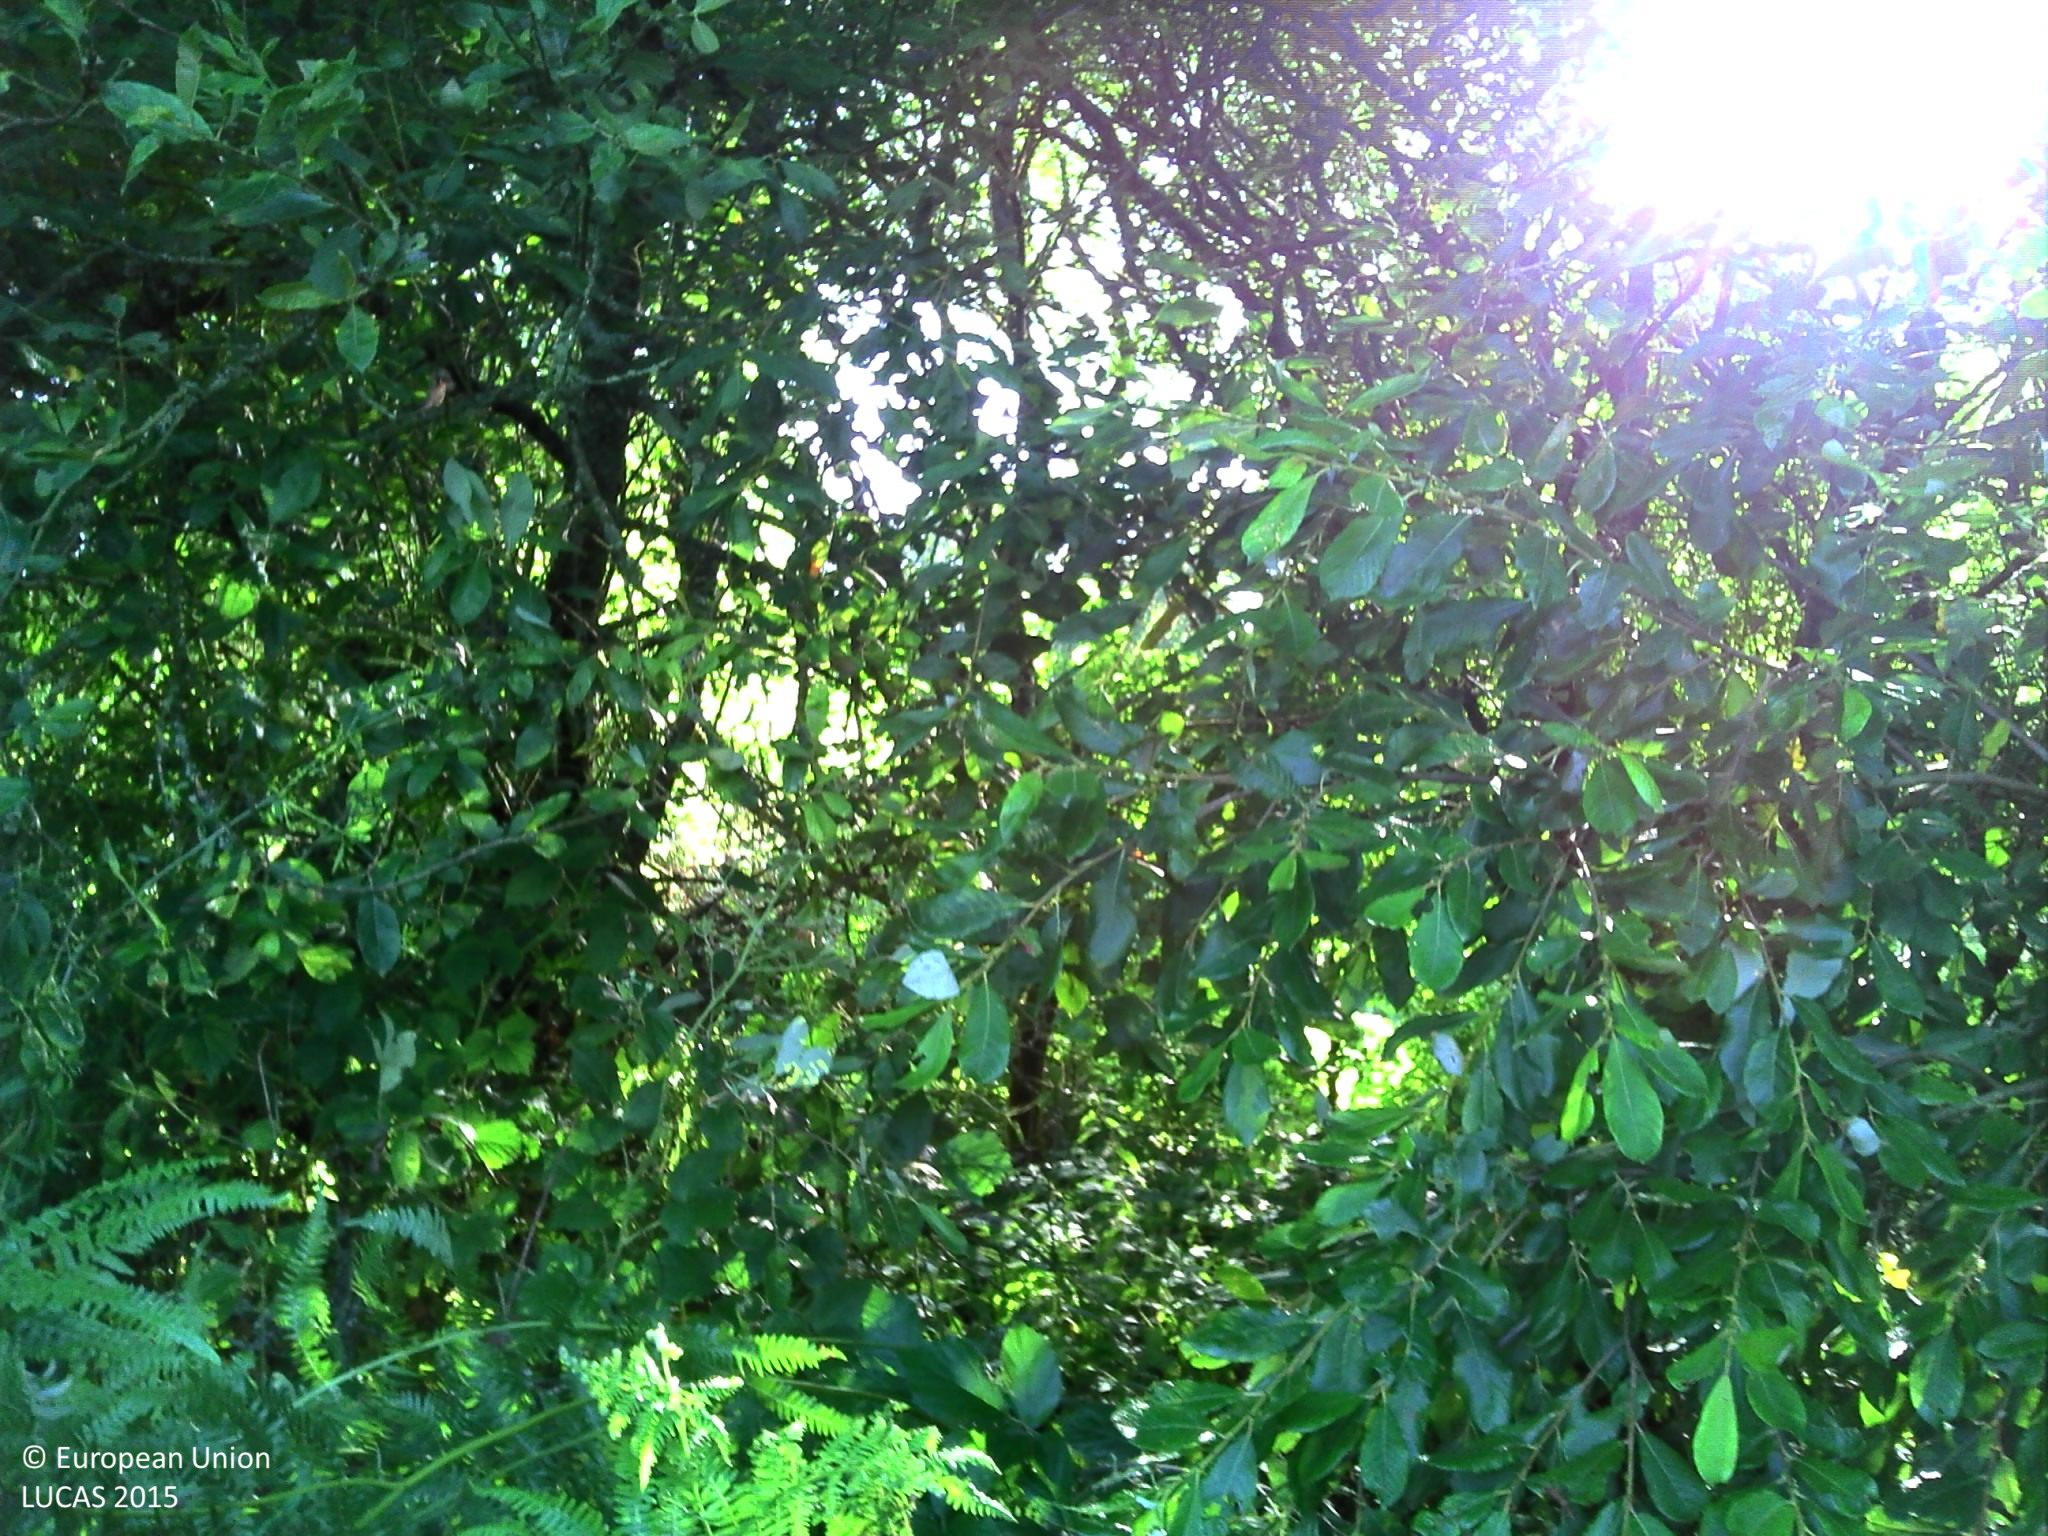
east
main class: Woodland
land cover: Broadleaved woodland
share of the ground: > 75 %
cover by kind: broadleaved forest trees 90 %, herbaceous plants 10 %
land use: Semi-natural and natural areas not in use
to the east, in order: Broadleaved woodland; Ditches and canals; Broadleaved woodland; Spontaneously vegetated surfaces; Broadleaved woodland; Ditches and canals; Grass margins; Paved roads, cycling and walking lanes; Grass margins; Ditches and canals; Lines of trees; Grassland without tree/shrub cover; Lines of trees; Grassland without tree/shrub cover
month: July
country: FR
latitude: 48.1621
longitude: -3.2897
